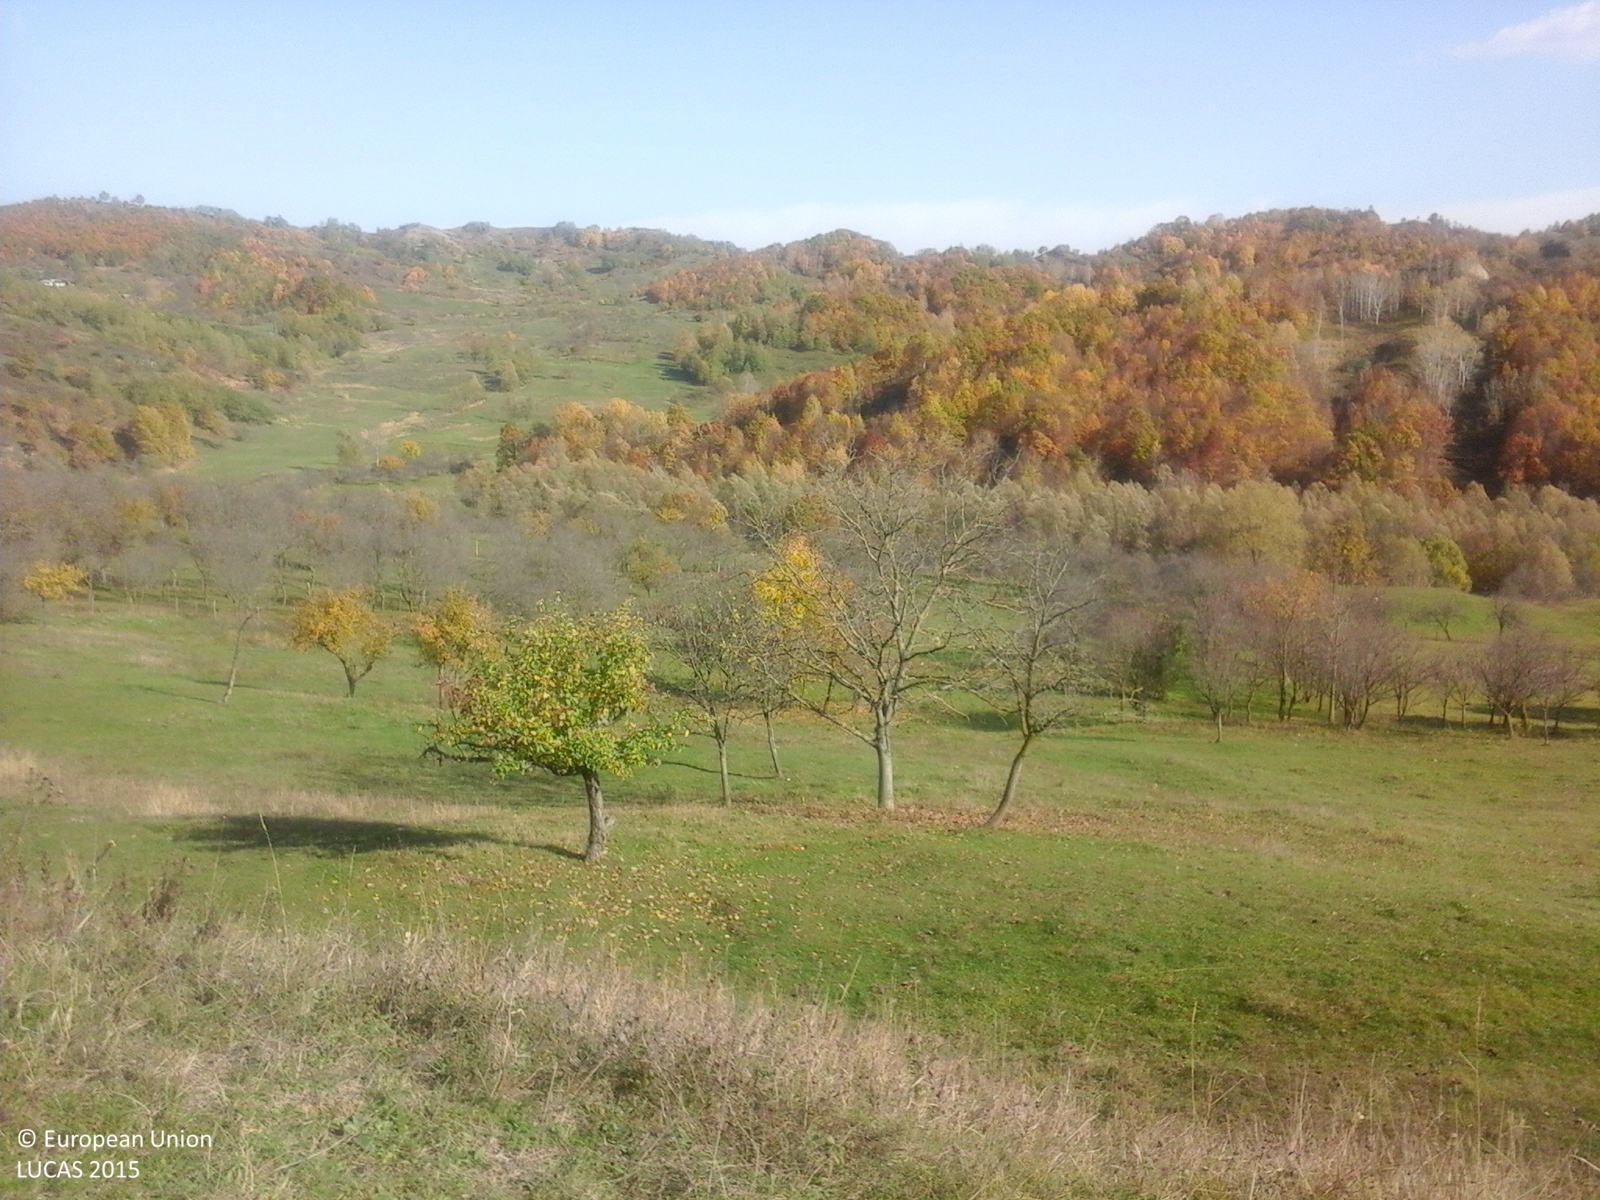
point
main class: Grassland
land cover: Grassland with sparse tree/shrub cover
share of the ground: > 75 %
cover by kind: herbaceous plants 95 %, broadleaved forest trees 5 %
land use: Agriculture (excluding fallow land and kitchen gardens)
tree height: > 5 m
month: October
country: RO
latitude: 45.5976
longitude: 26.9189
